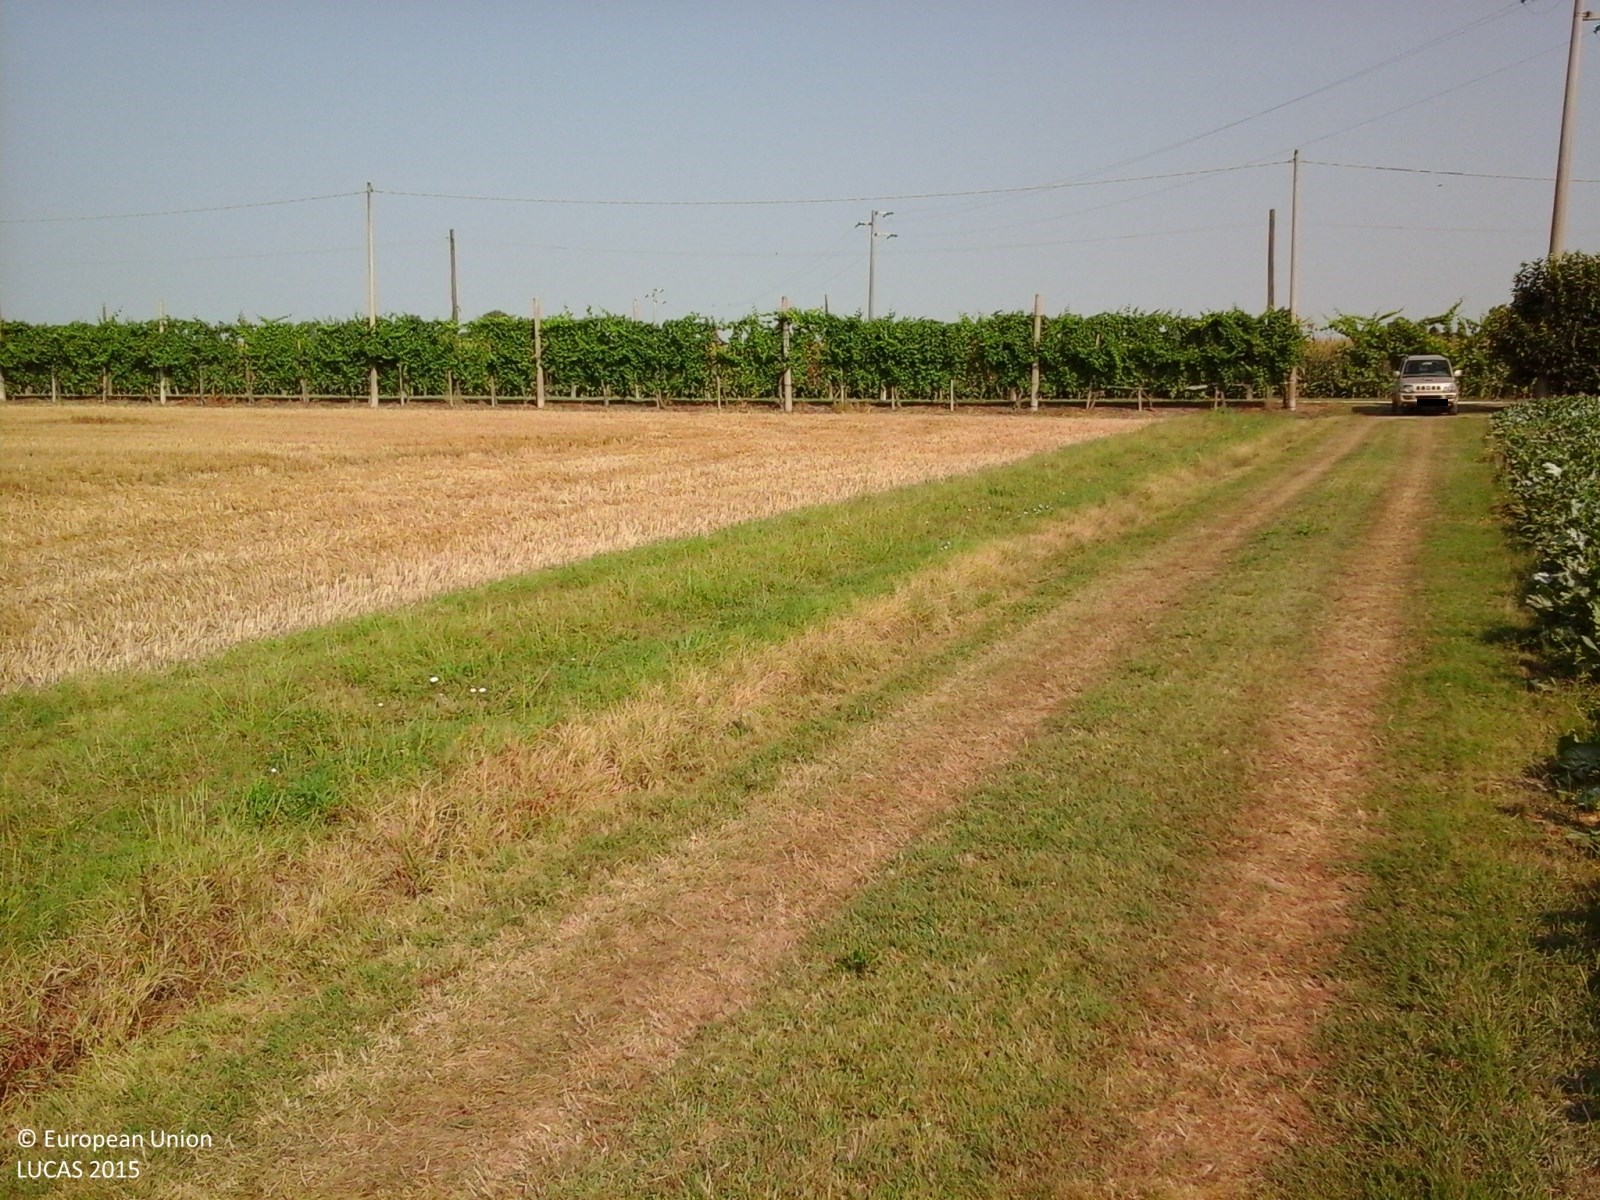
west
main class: Cropland
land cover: Sugar beet
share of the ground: > 75 %
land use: Agriculture (excluding fallow land and kitchen gardens)
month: July
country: IT
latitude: 44.7354
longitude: 11.5753
